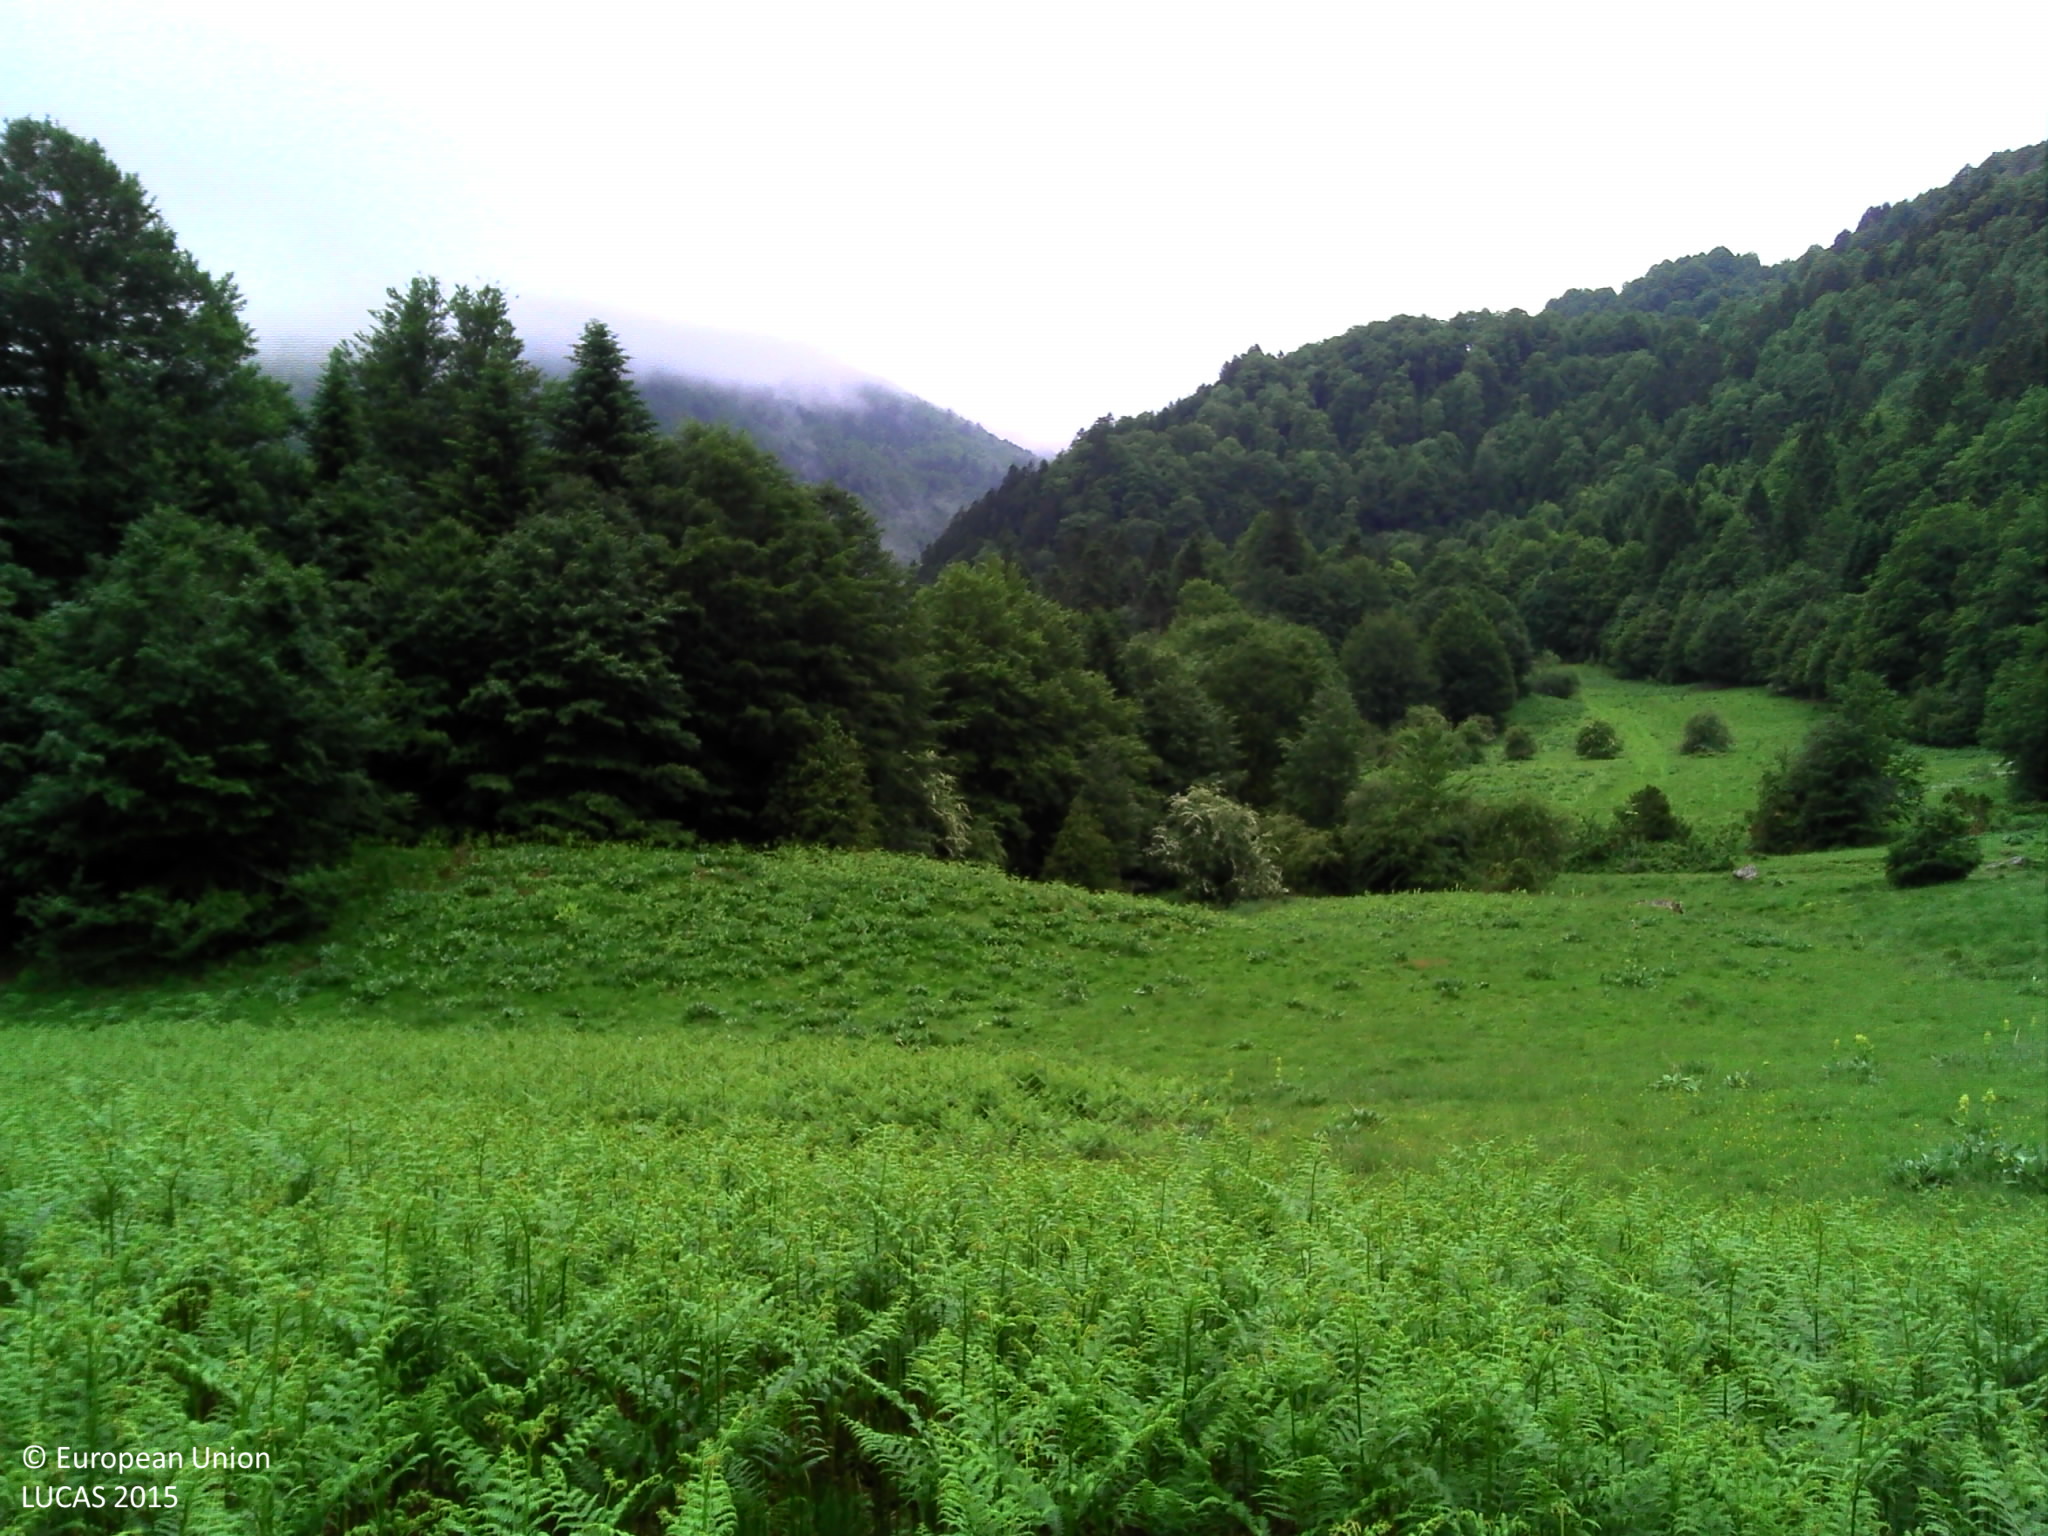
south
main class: Grassland
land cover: Grassland without tree/shrub cover
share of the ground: > 75 %
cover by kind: herbaceous plants 95 %, shrubs 5 %
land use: Agriculture (excluding fallow land and kitchen gardens)
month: June
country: FR
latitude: 42.8103
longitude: -0.5585
